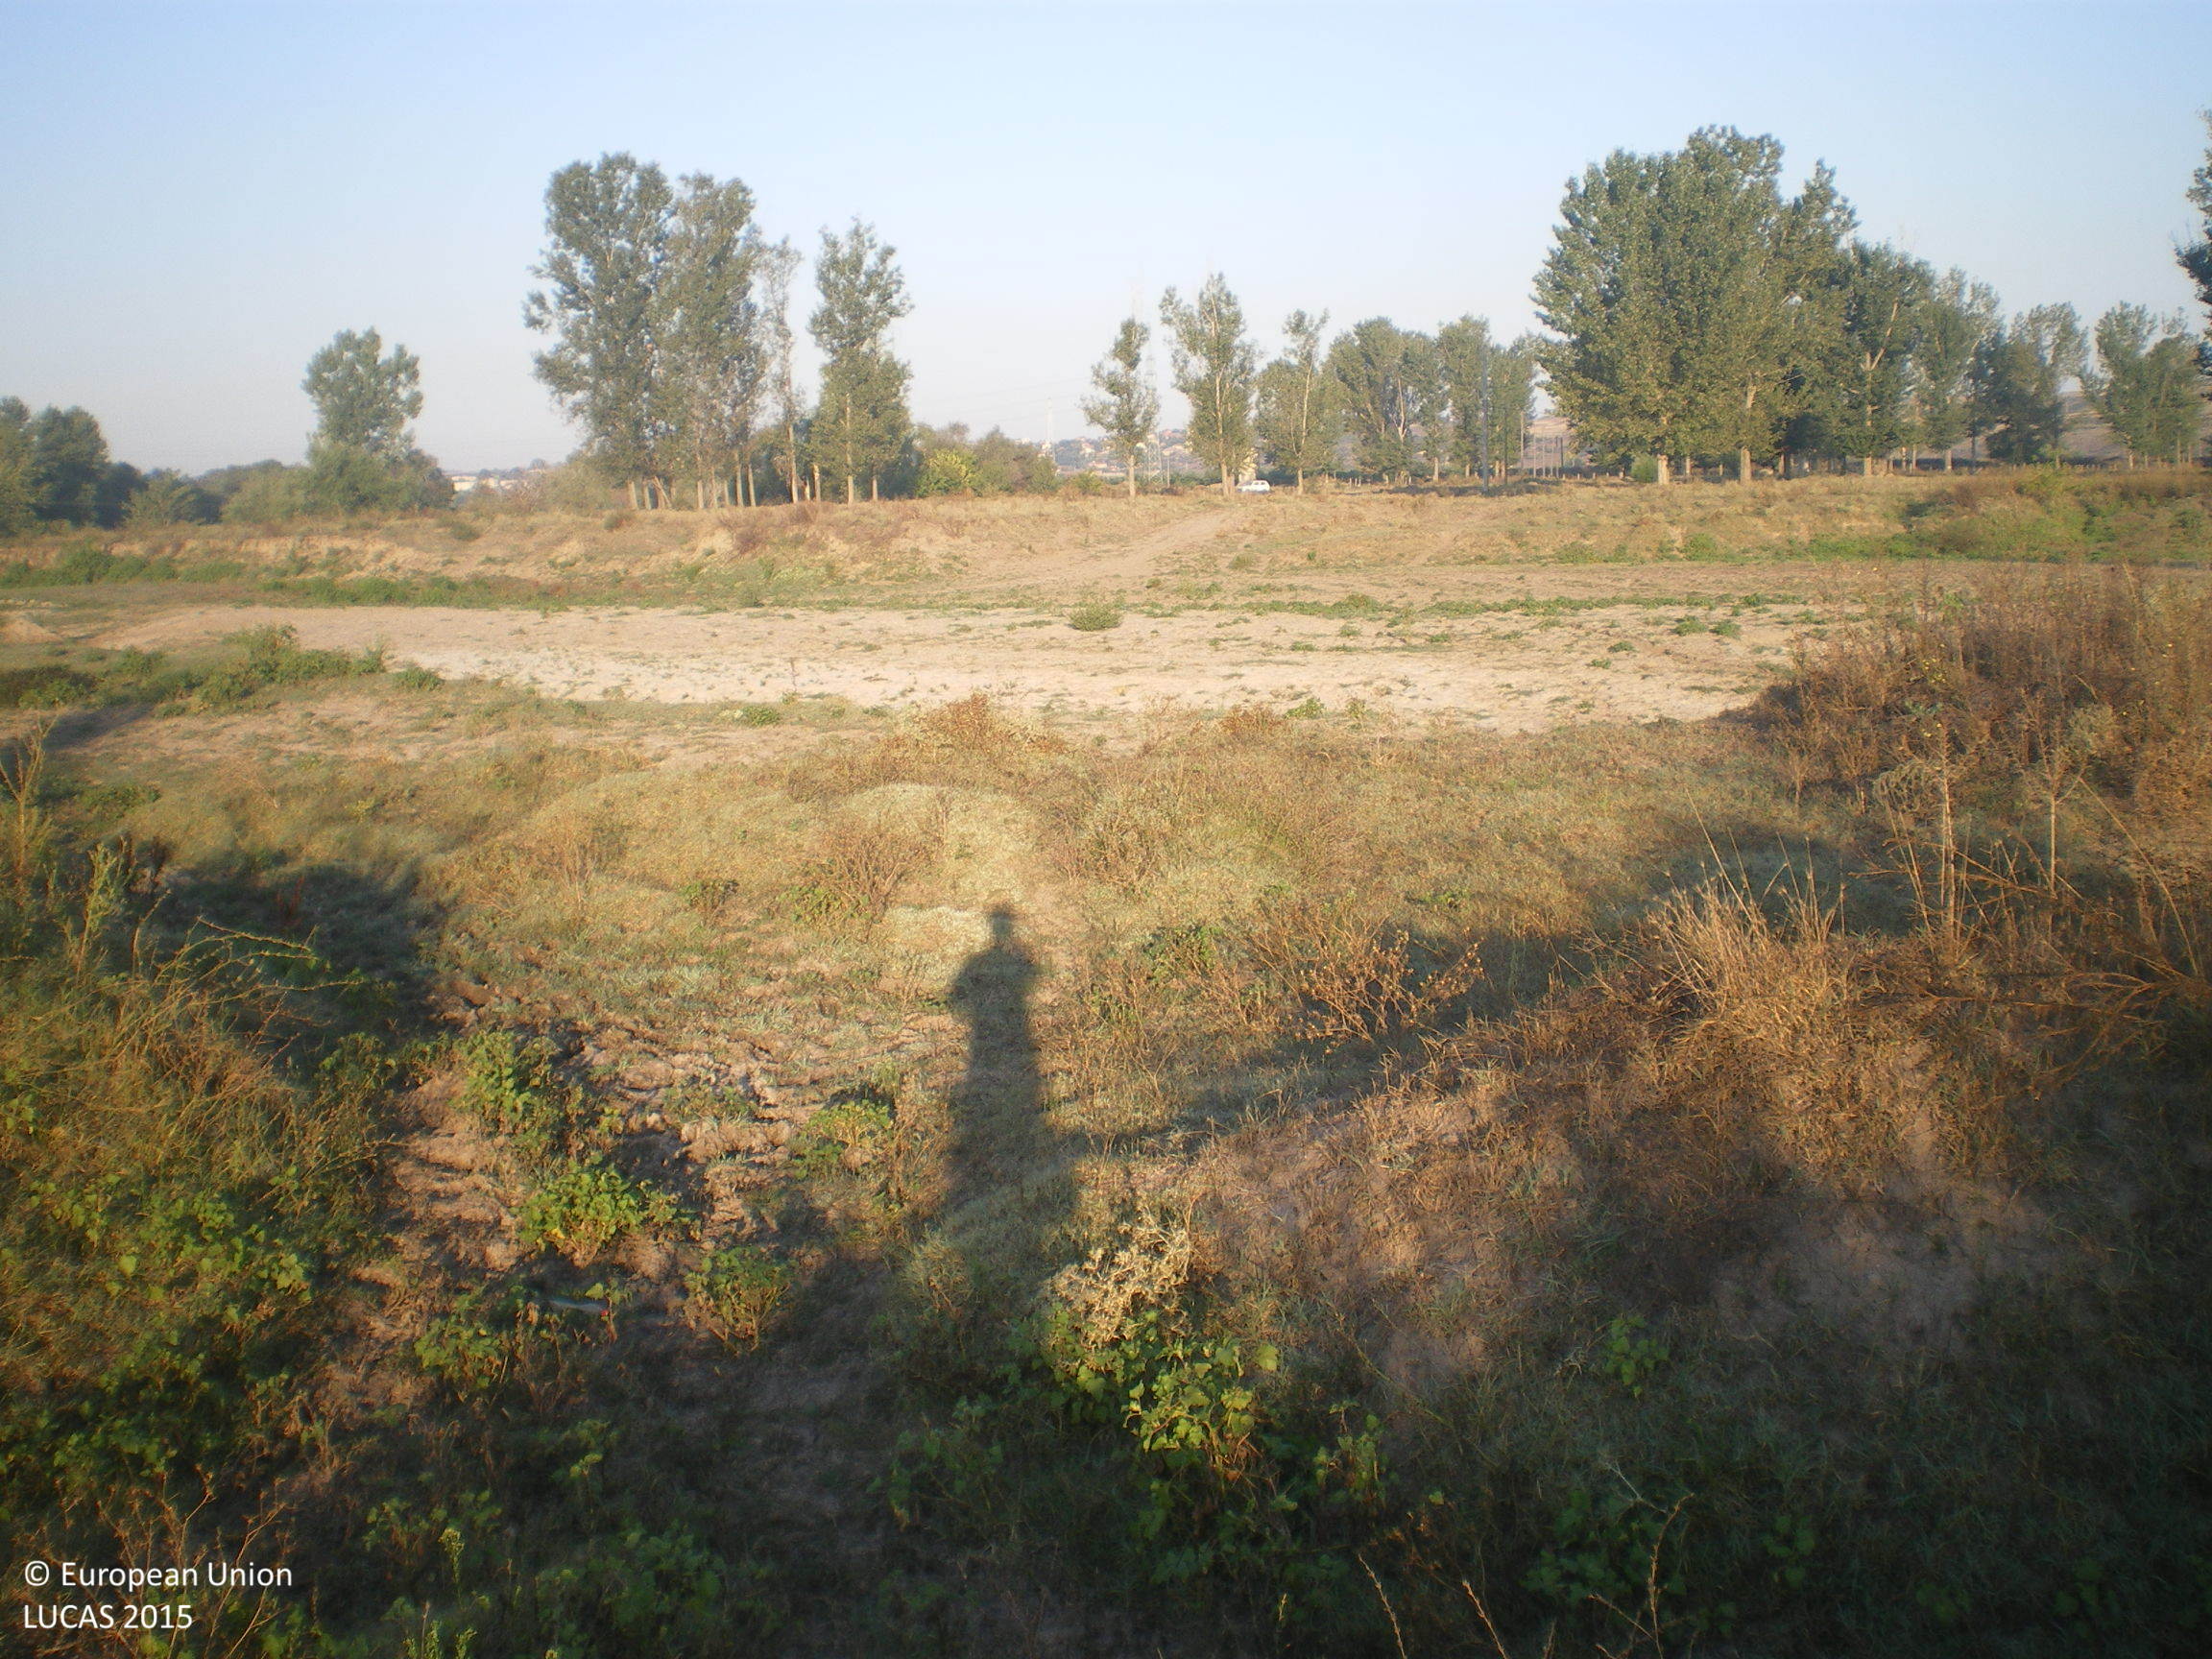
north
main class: Grassland
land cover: Grassland with sparse tree/shrub cover
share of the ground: > 75 %
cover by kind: herbaceous plants 90 %, broadleaved forest trees 5 %, shrubs 5 %
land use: Agriculture (excluding fallow land and kitchen gardens)
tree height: > 5 m
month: August
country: BG
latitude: 42.0380
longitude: 25.8605
